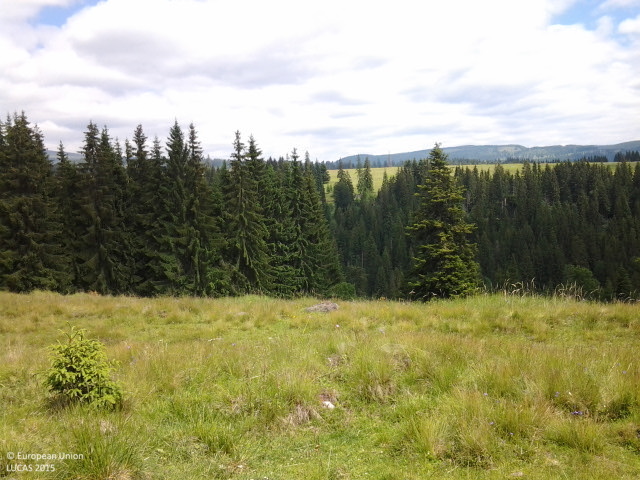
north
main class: Grassland
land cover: Grassland without tree/shrub cover
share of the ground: > 75 %
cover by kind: herbaceous plants 100 %
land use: Agriculture (excluding fallow land and kitchen gardens)
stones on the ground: 10 - 25 %
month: June
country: RO
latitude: 47.0501
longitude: 25.3392
